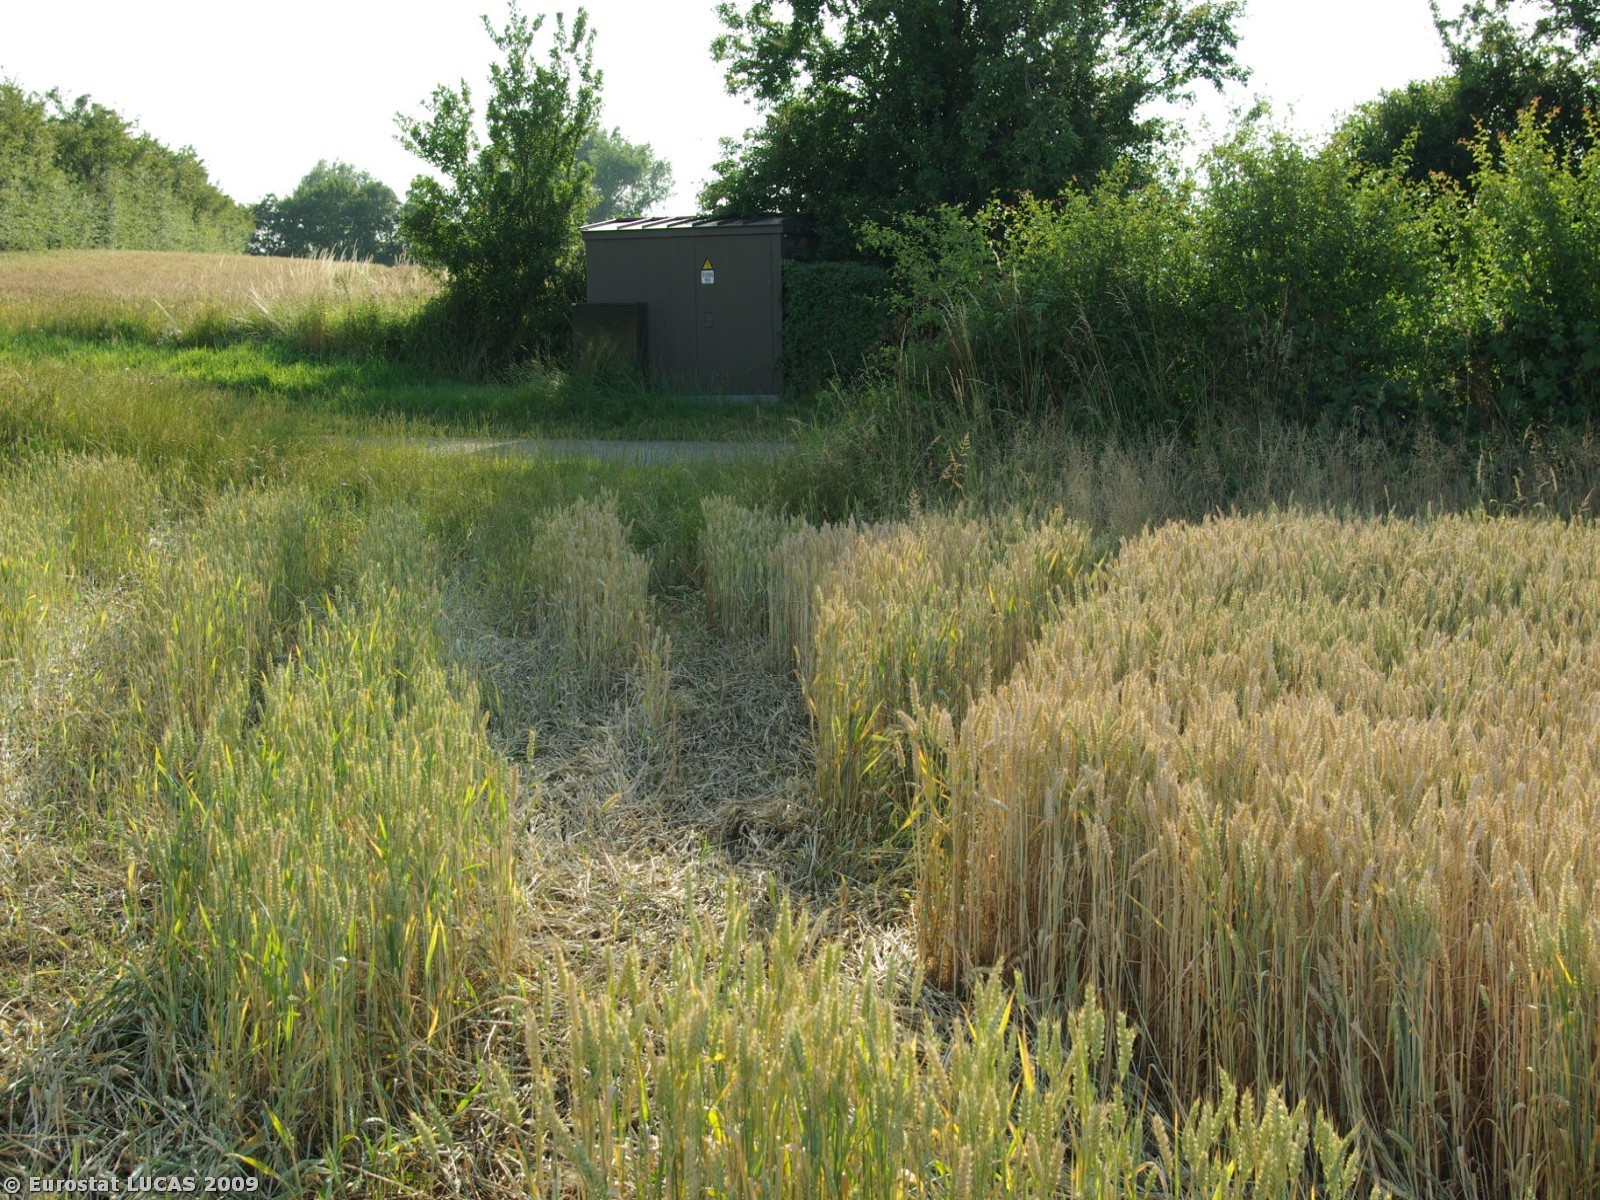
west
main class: Cropland
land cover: Common wheat
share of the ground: > 75 %
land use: Agriculture (excluding fallow land and kitchen gardens)
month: July
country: DK
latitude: 55.0191
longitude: 9.7343
